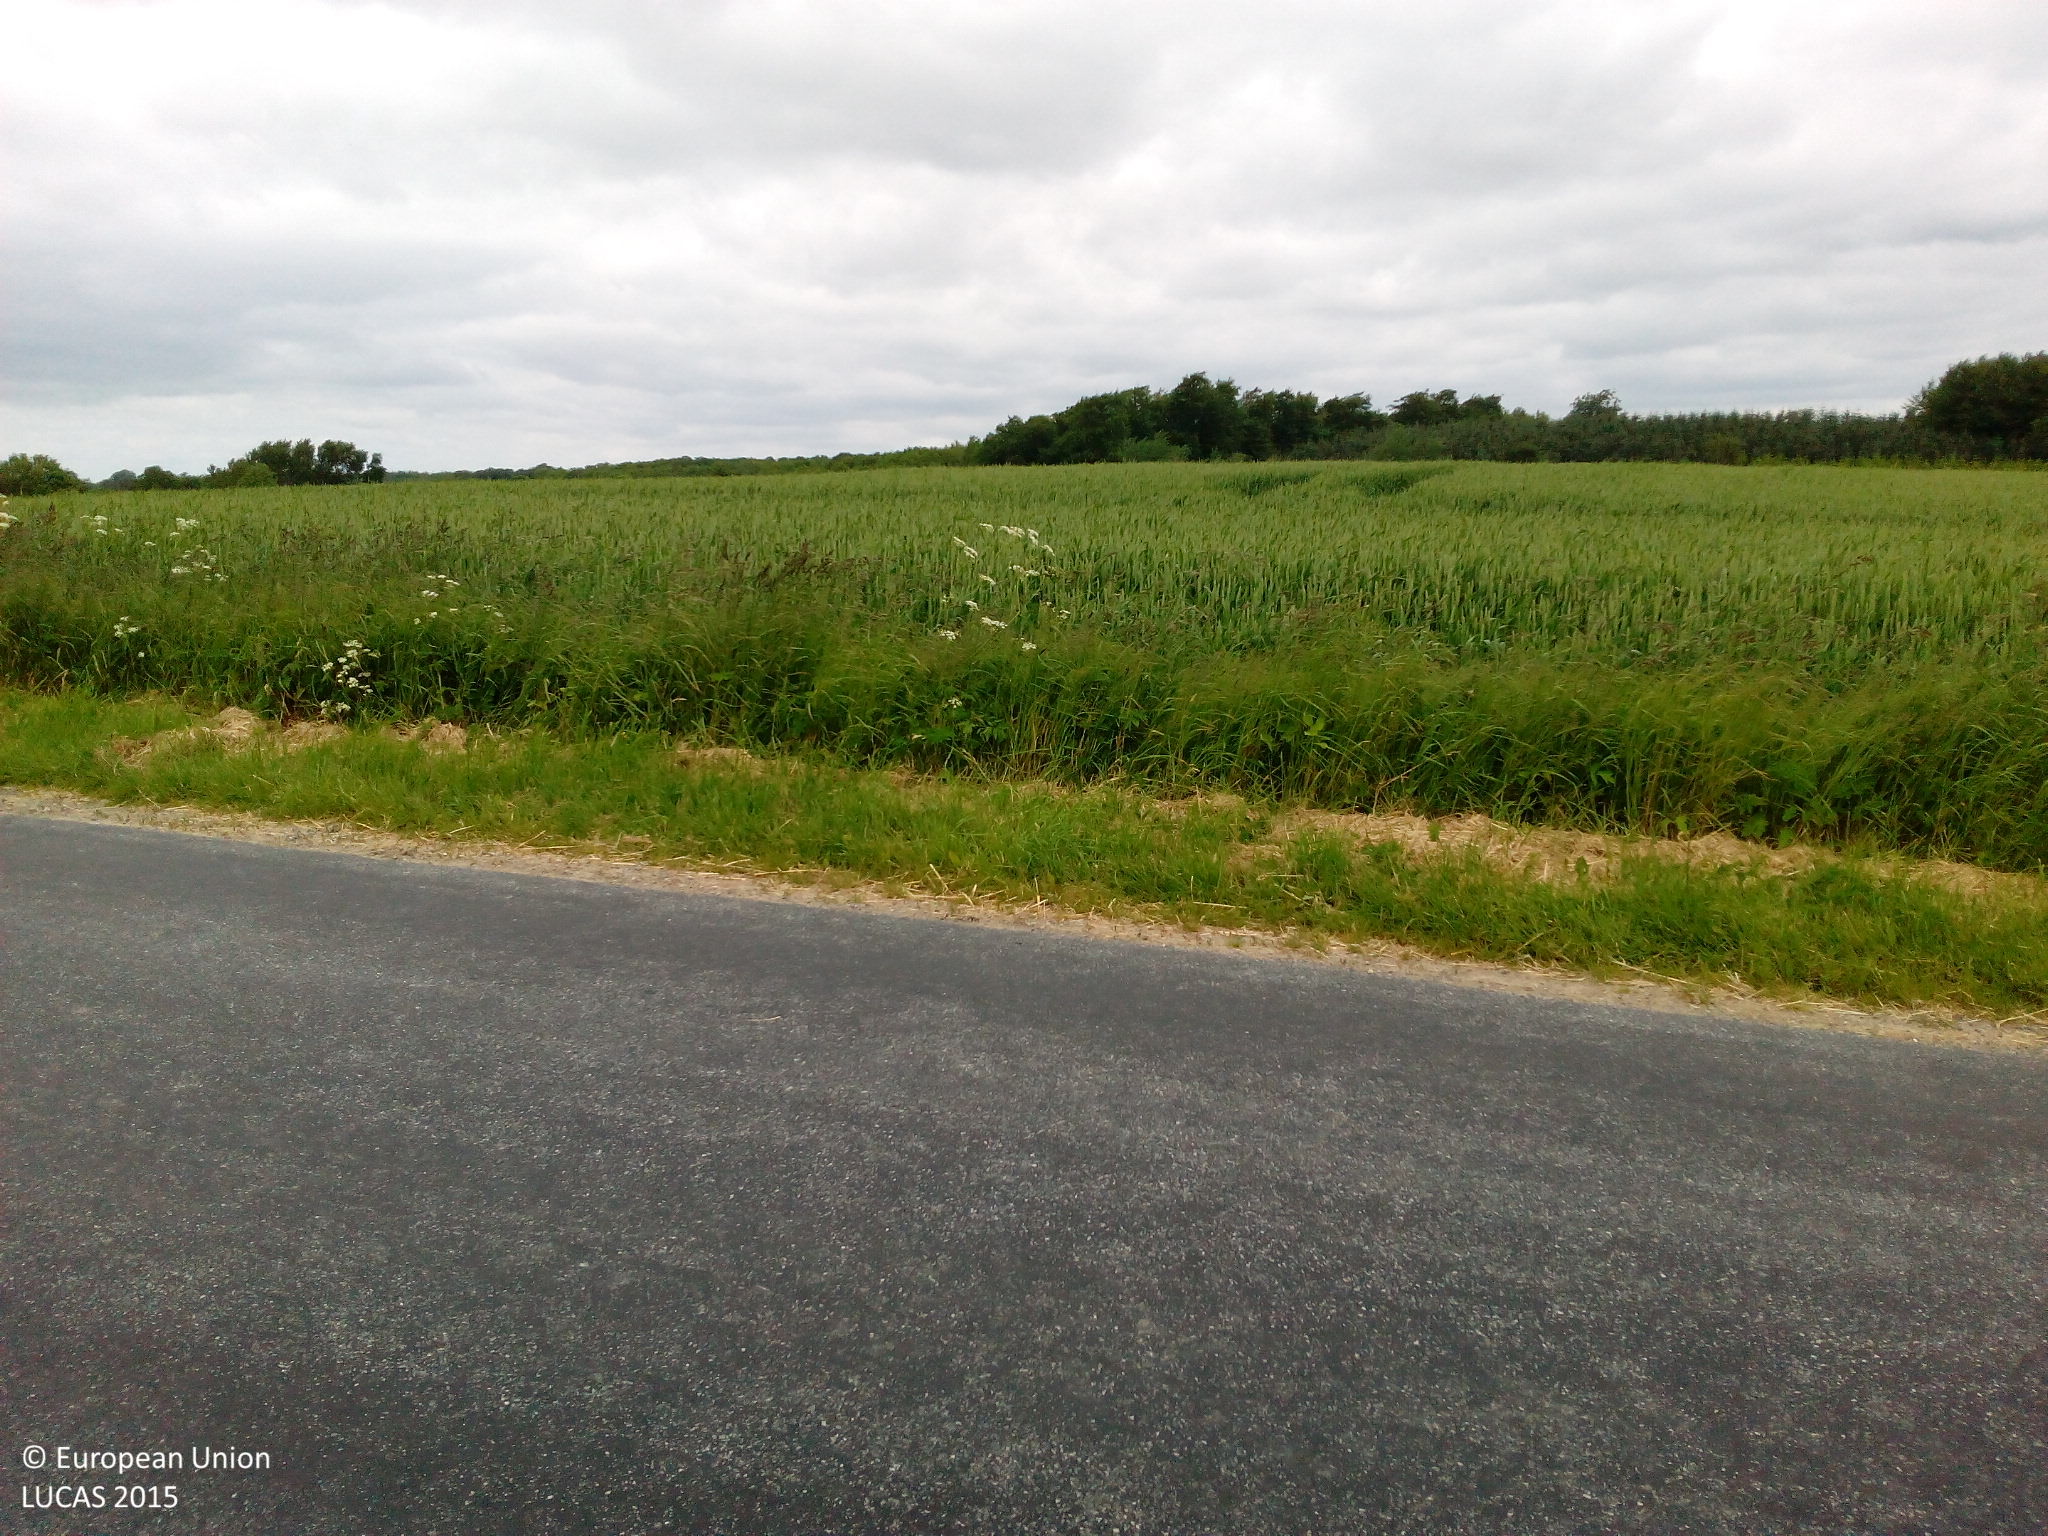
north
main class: Cropland
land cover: Common wheat
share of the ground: > 75 %
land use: Agriculture (excluding fallow land and kitchen gardens)
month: June
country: DK
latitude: 55.1794
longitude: 10.6747
